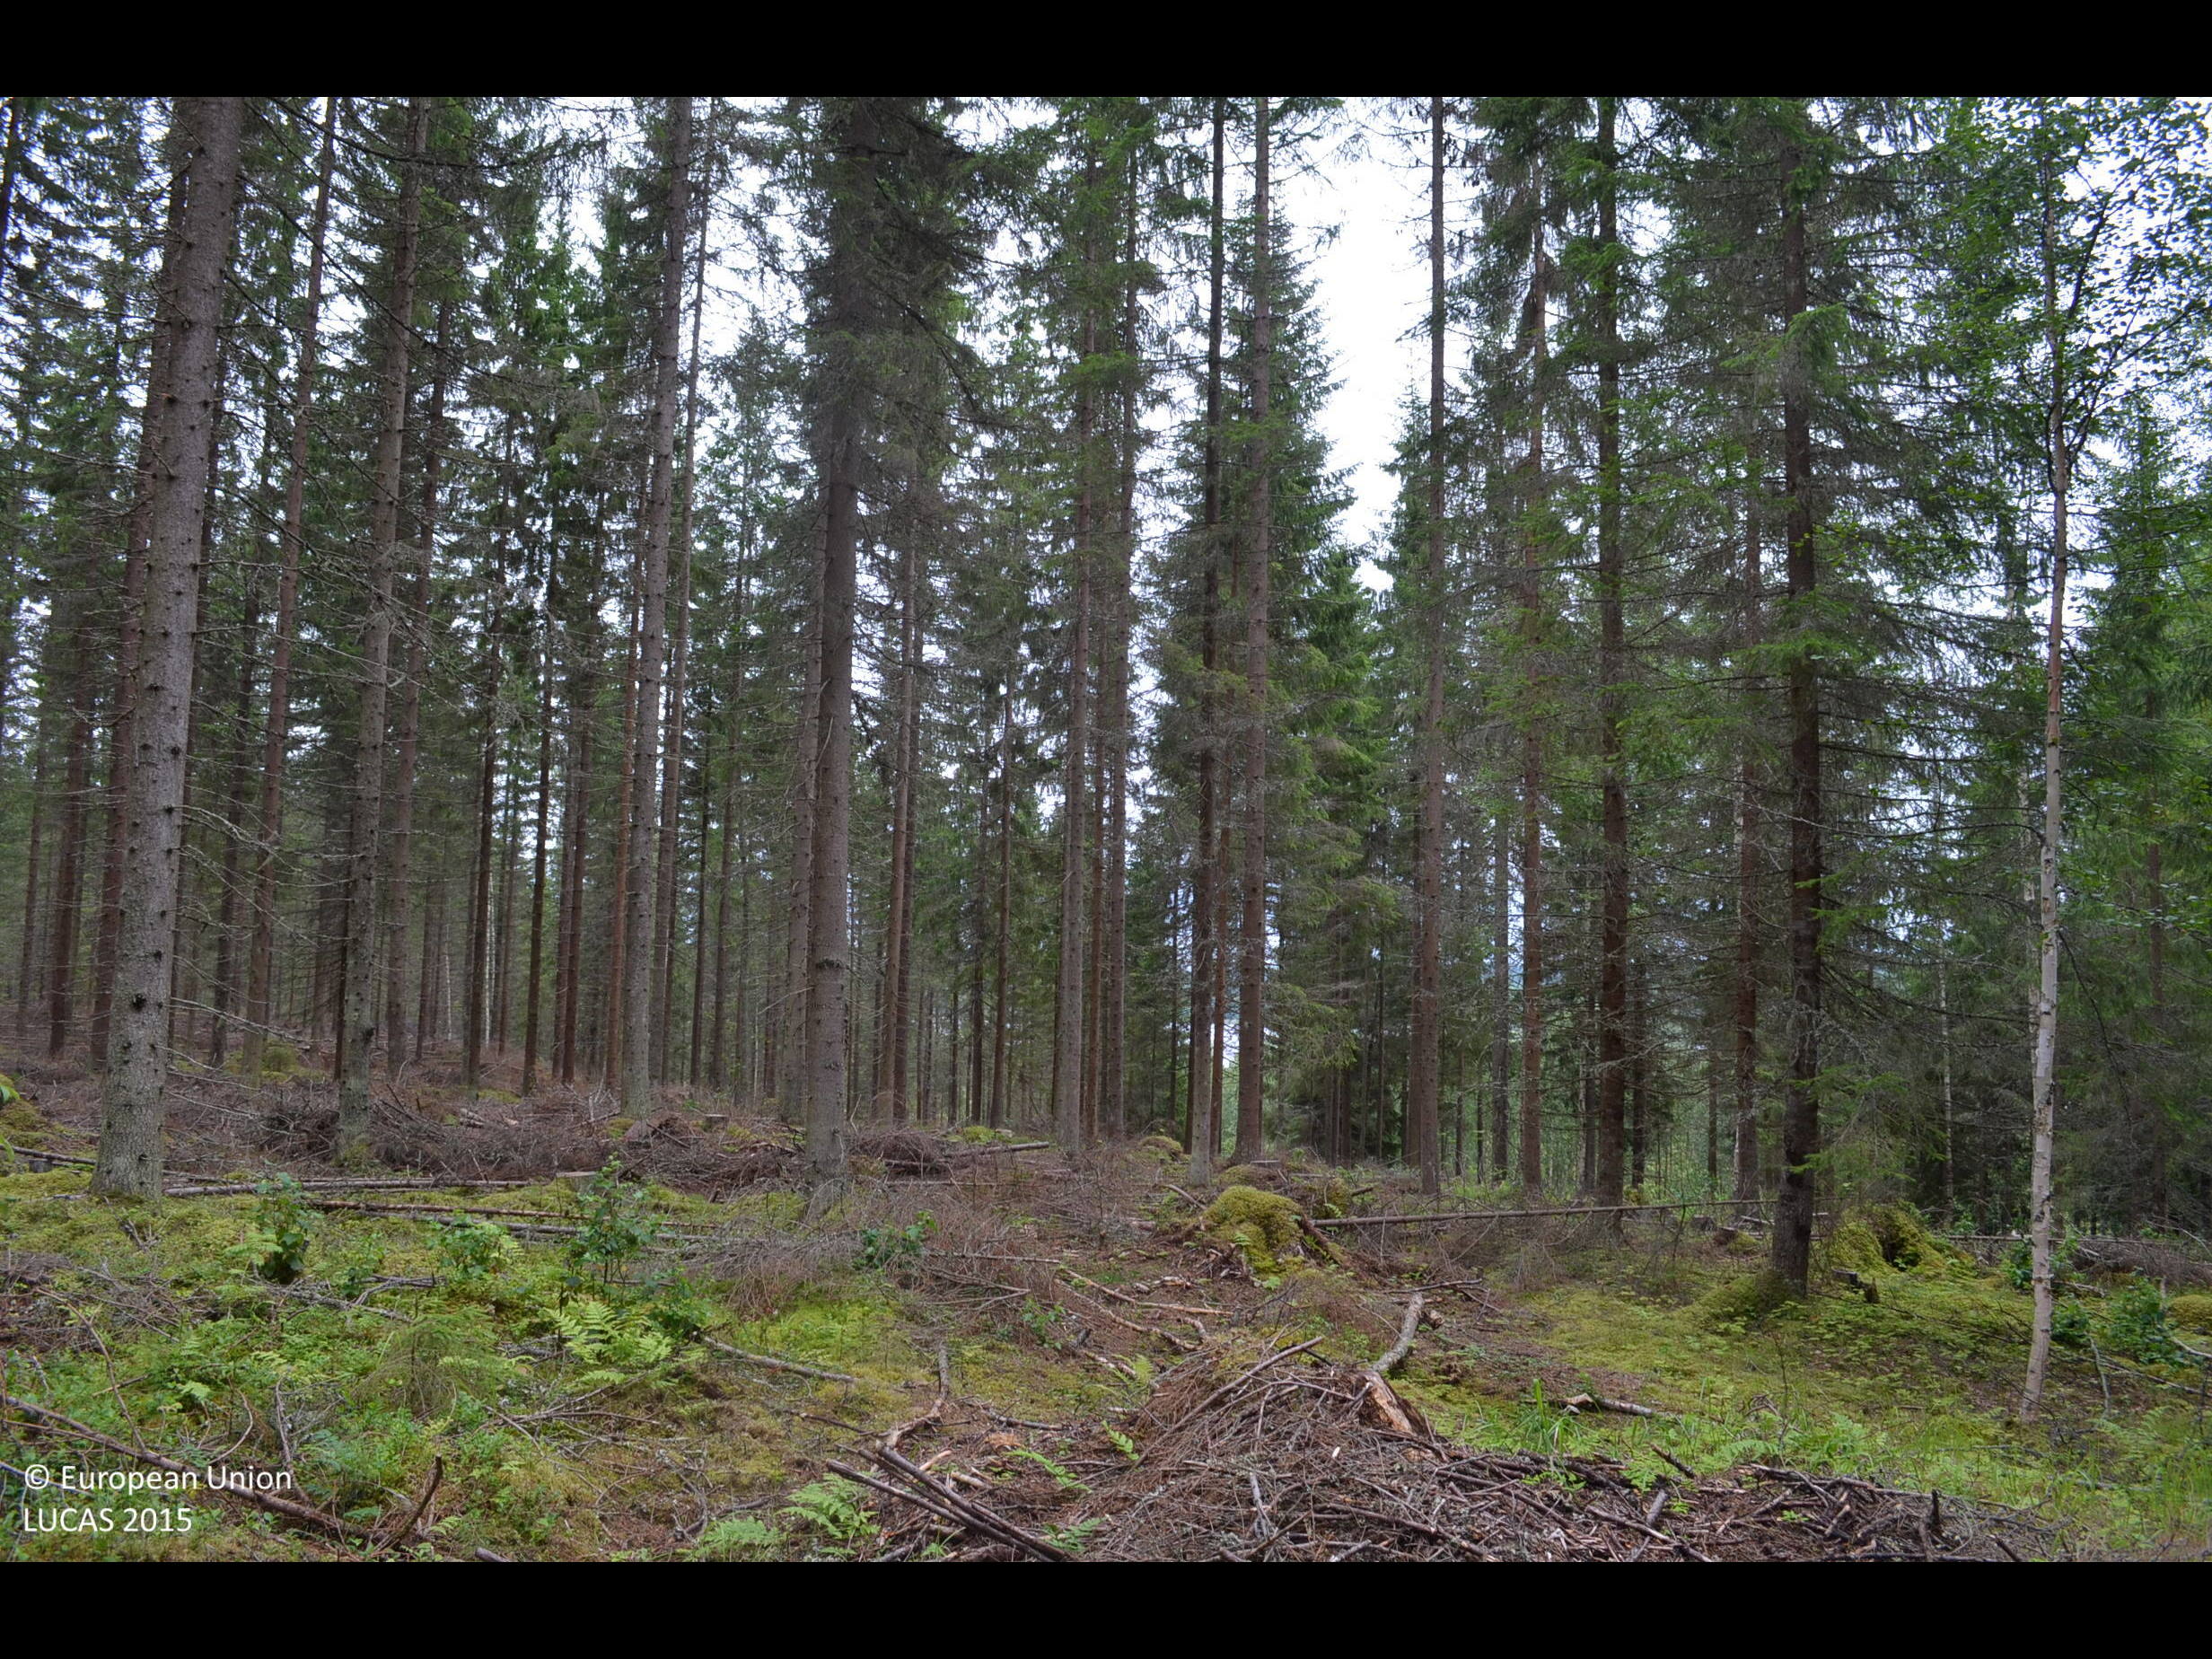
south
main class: Woodland
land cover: Spruce dominated coniferous woodland
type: boreal forest
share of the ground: 50 - 75 %
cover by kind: coniferous forest trees 65 %, shrubs 10 %, herbaceous plants 5 %, lichens and mosses 5 %
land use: Forestry
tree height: > 5 m
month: August
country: FI
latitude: 61.8919
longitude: 24.0711
